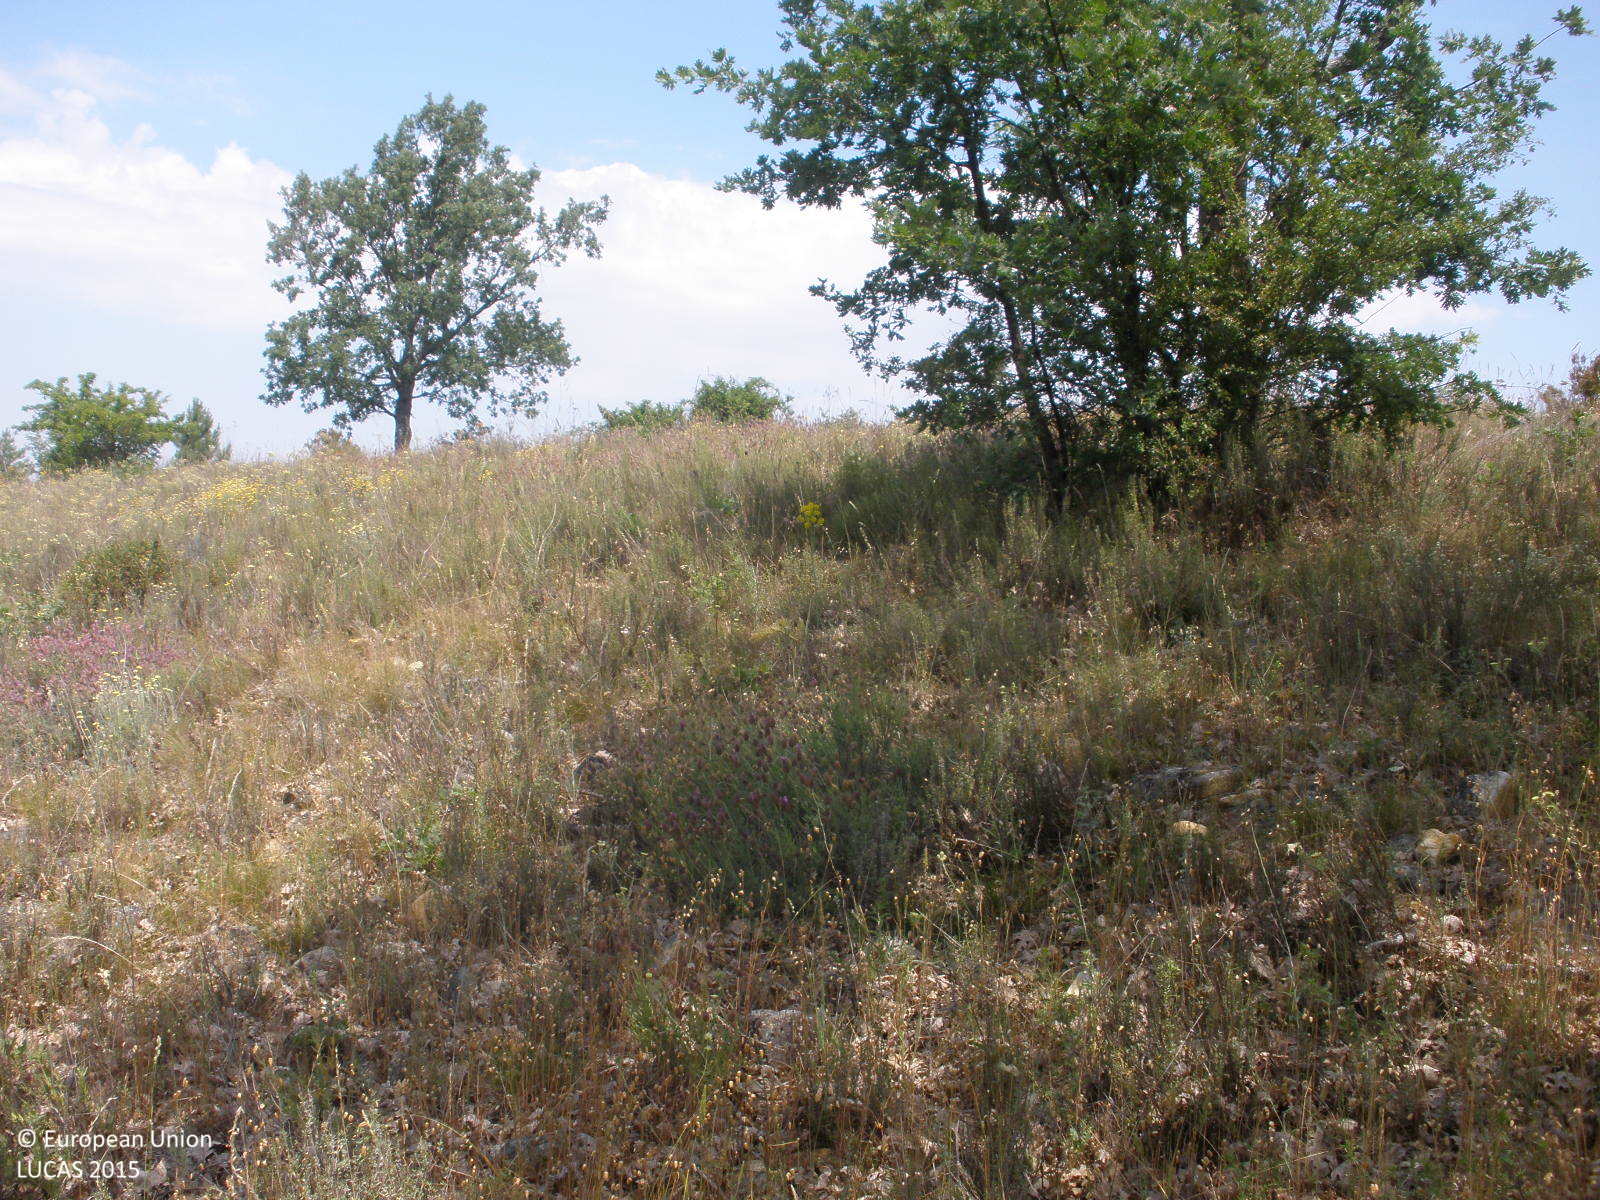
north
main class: Woodland
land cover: Broadleaved woodland
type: thermophilous deciduous forest
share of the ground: > 75 %
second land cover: Grassland without tree/shrub cover
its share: > 75 %
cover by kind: broadleaved forest trees 60 %, herbaceous plants 30 %, shrubs 10 %
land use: Forestry
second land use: Agriculture (excluding fallow land and kitchen gardens)
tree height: > 5 m
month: June
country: ES
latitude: 40.5863
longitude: -6.3066
